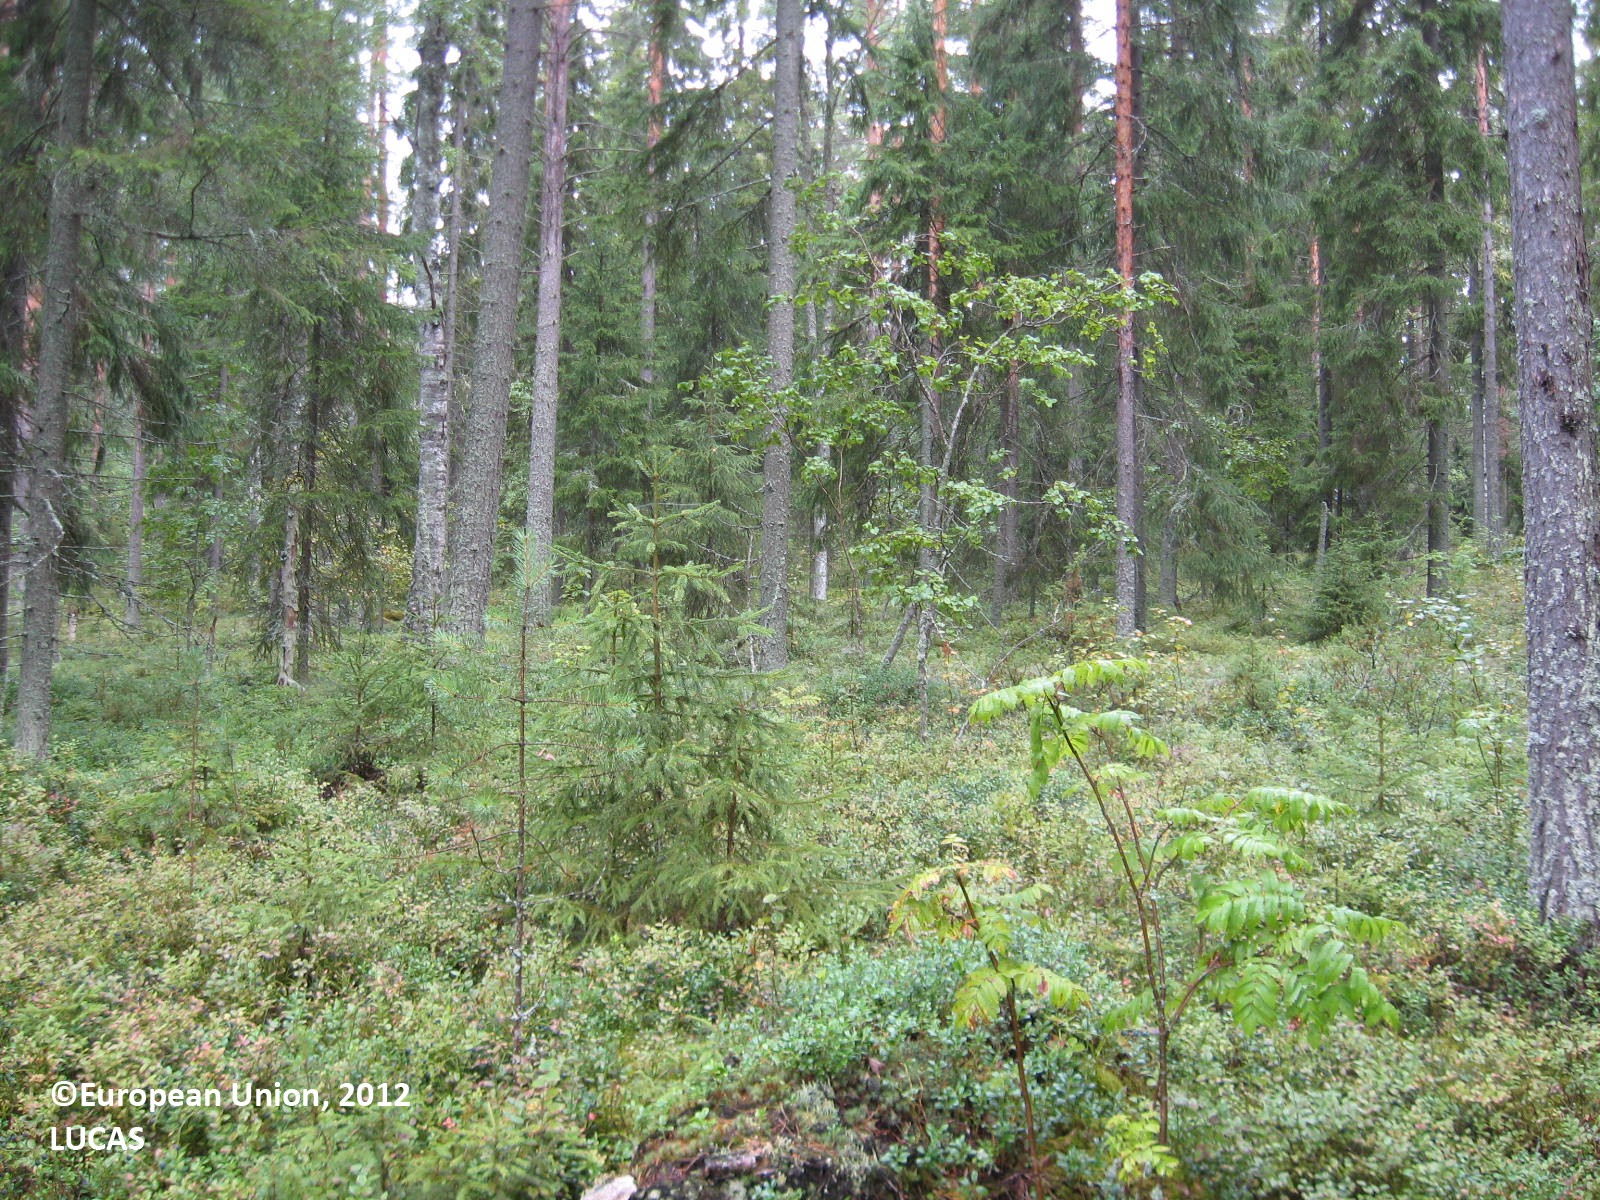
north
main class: Woodland
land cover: Other mixed woodland
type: boreal forest
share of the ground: > 75 %
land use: Forestry
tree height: > 5 m
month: August
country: FI
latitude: 63.3968
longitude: 29.7542
